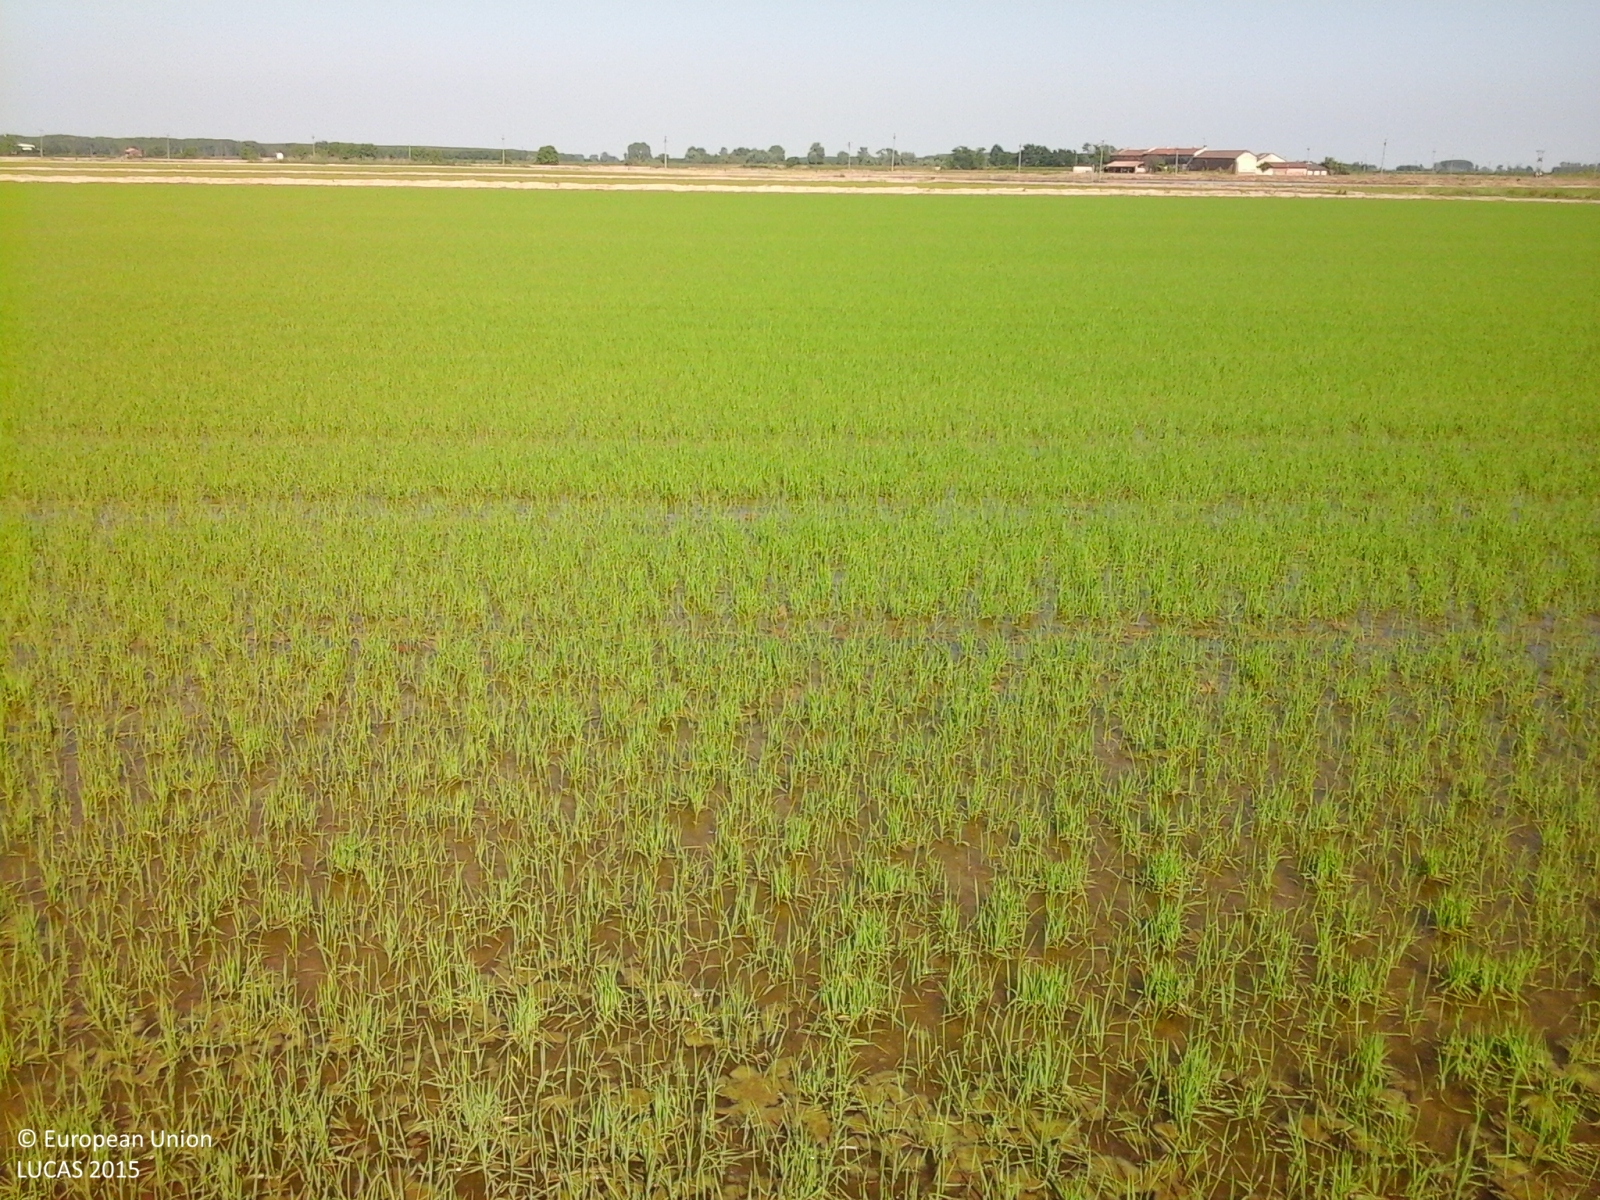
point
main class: Cropland
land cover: Rice
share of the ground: 50 - 75 %
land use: Agriculture (excluding fallow land and kitchen gardens)
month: May
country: IT
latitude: 45.2596
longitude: 8.5116
